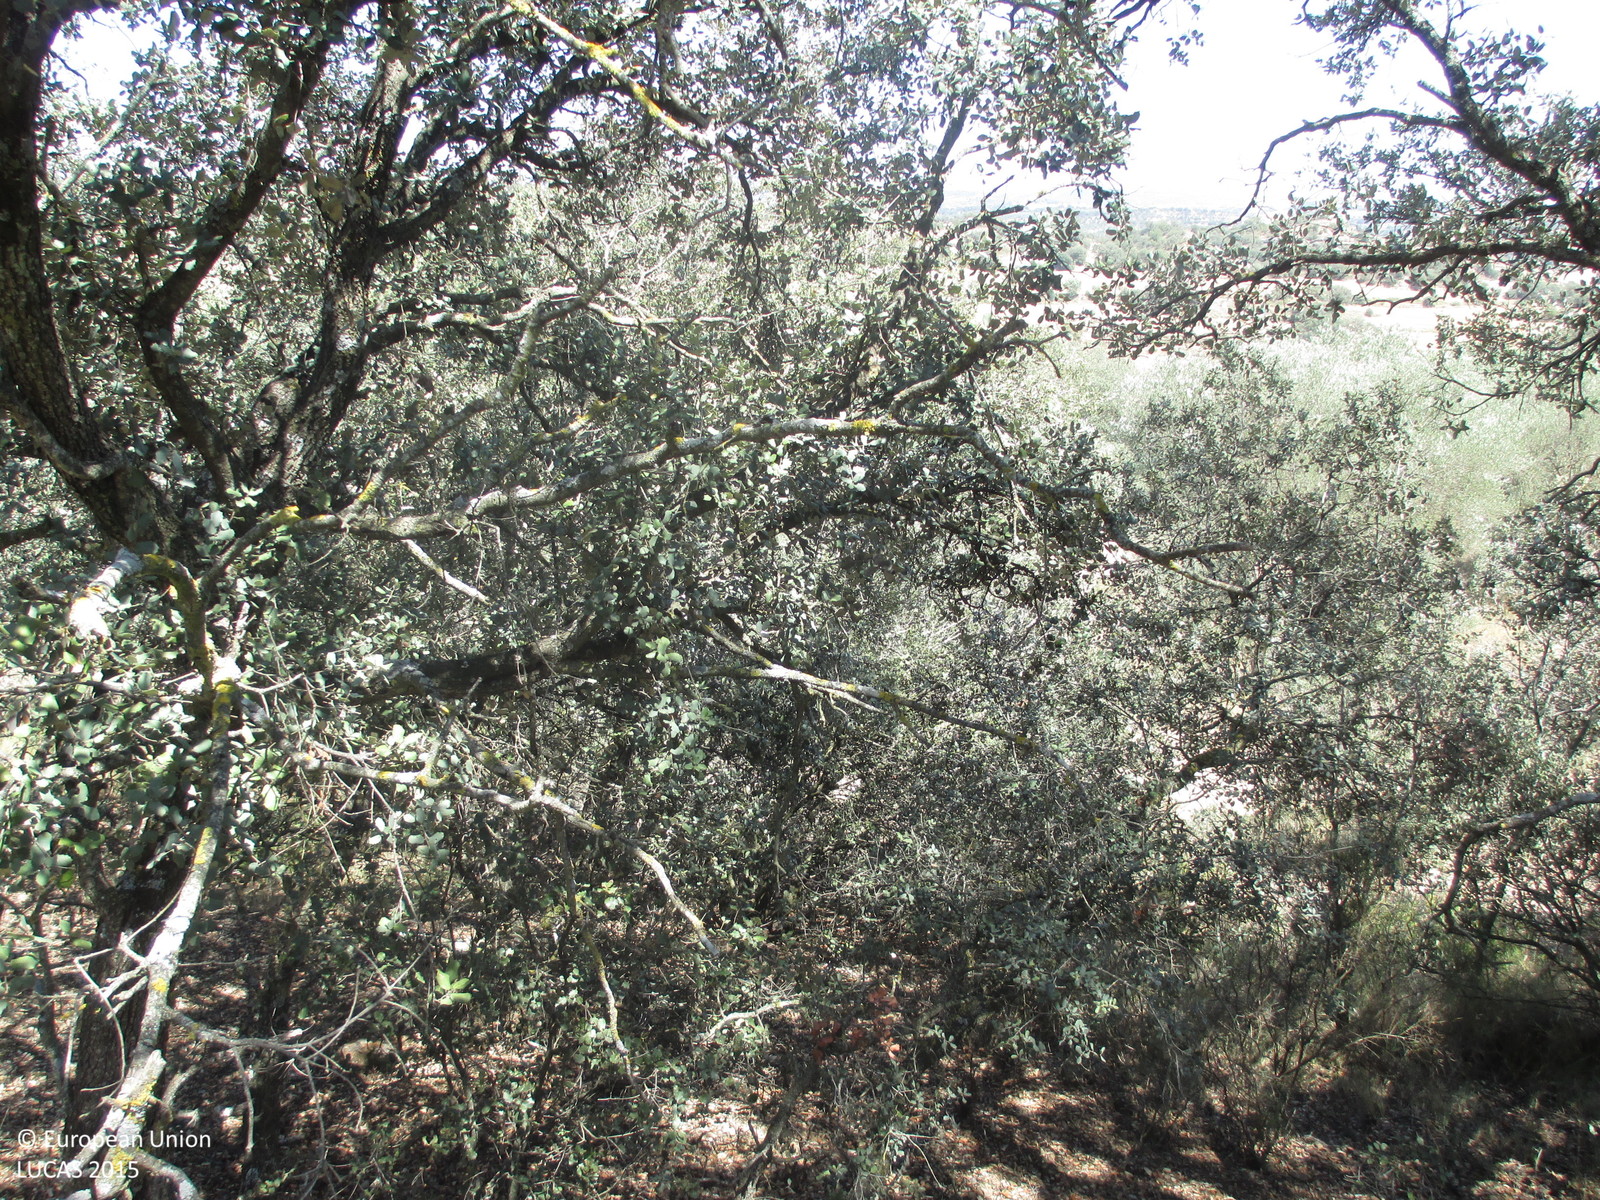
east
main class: Woodland
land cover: Broadleaved woodland
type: broadleaved evergreen forest
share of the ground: > 75 %
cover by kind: broadleaved forest trees 95 %, herbaceous plants 5 %
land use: Semi-natural and natural areas not in use
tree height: < 5 m
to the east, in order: Broadleaved woodland; Olive groves; Broadleaved woodland; Olive groves; Broadleaved woodland; Barley; Broadleaved woodland; Nuts trees; Shrubland with sparse tree cover; Tracks; Shruby margins; Barley; Broadleaved woodland; Common wheat
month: July
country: ES
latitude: 41.9531
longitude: 0.3203
